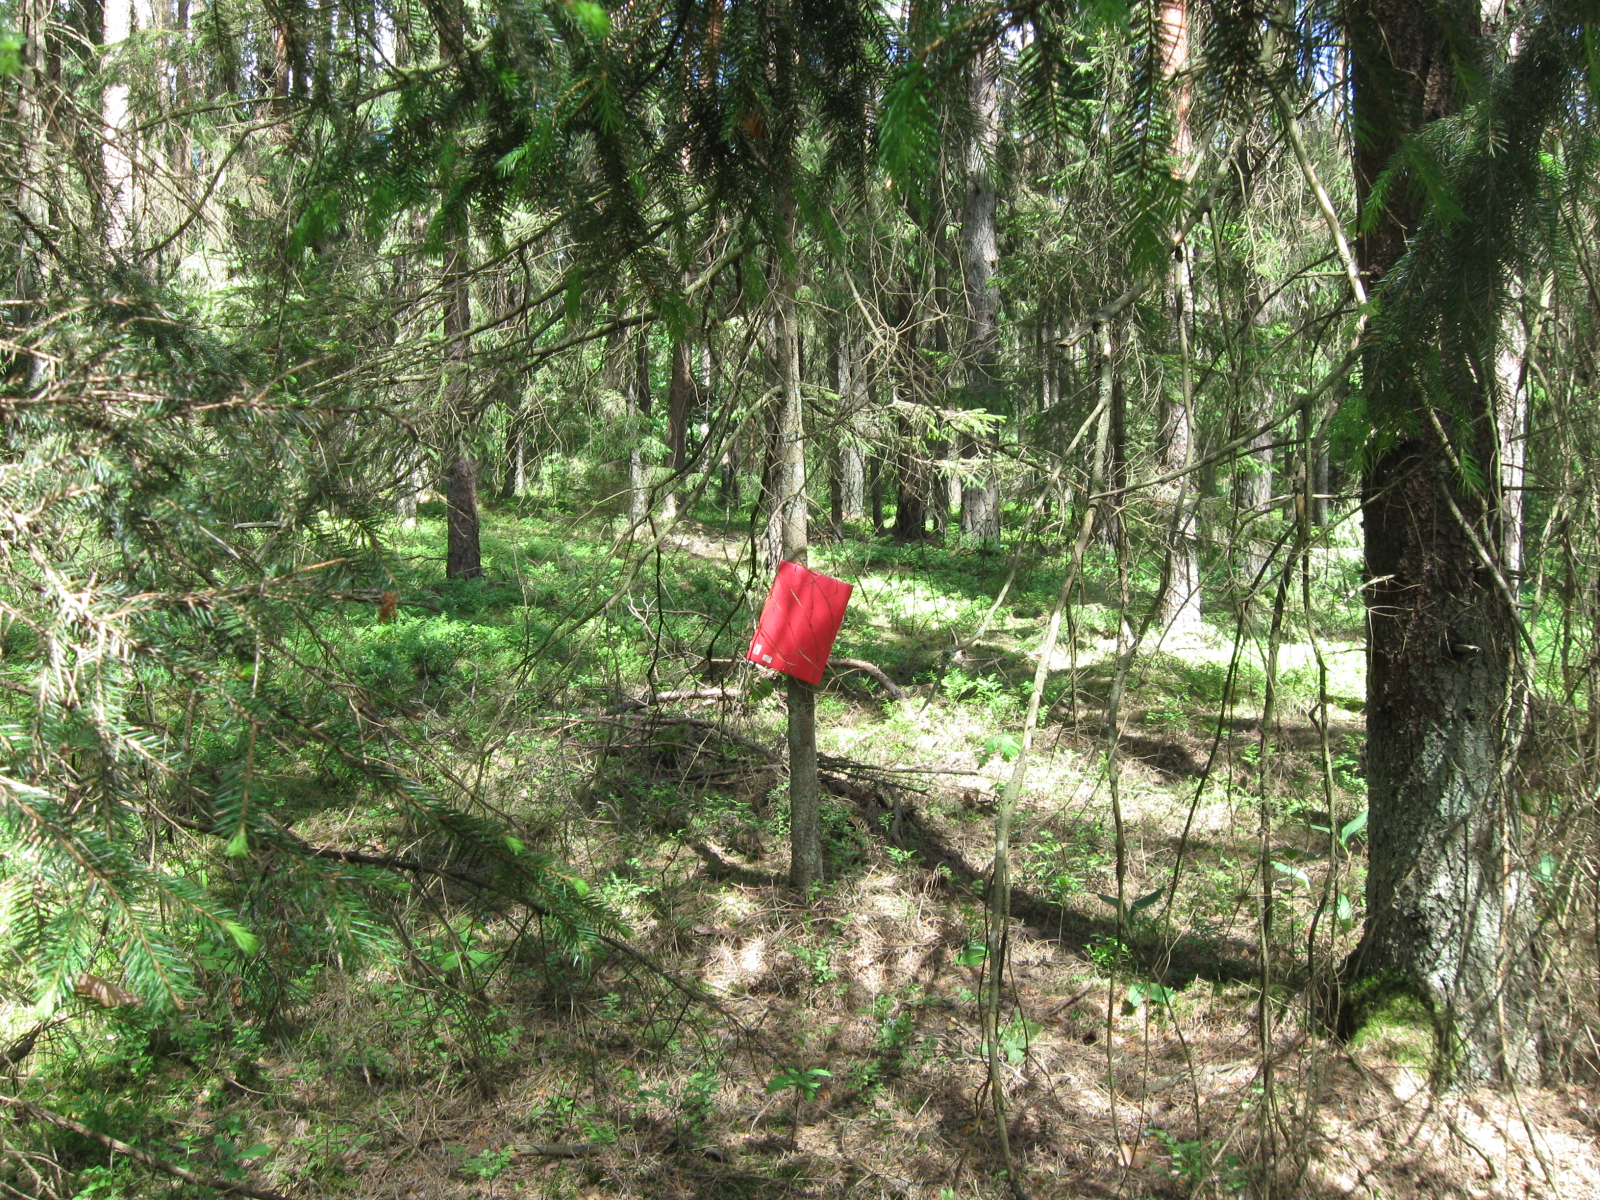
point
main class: Woodland
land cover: Other coniferous woodland
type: hemiboreal forest and nemoral coniferous forest and mixed broadleaved-coniferous forest
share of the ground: > 75 %
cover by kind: coniferous forest trees 90 %, herbaceous plants 10 %
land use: Forestry
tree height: > 5 m
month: June
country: LT
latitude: 54.6161
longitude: 23.7920
